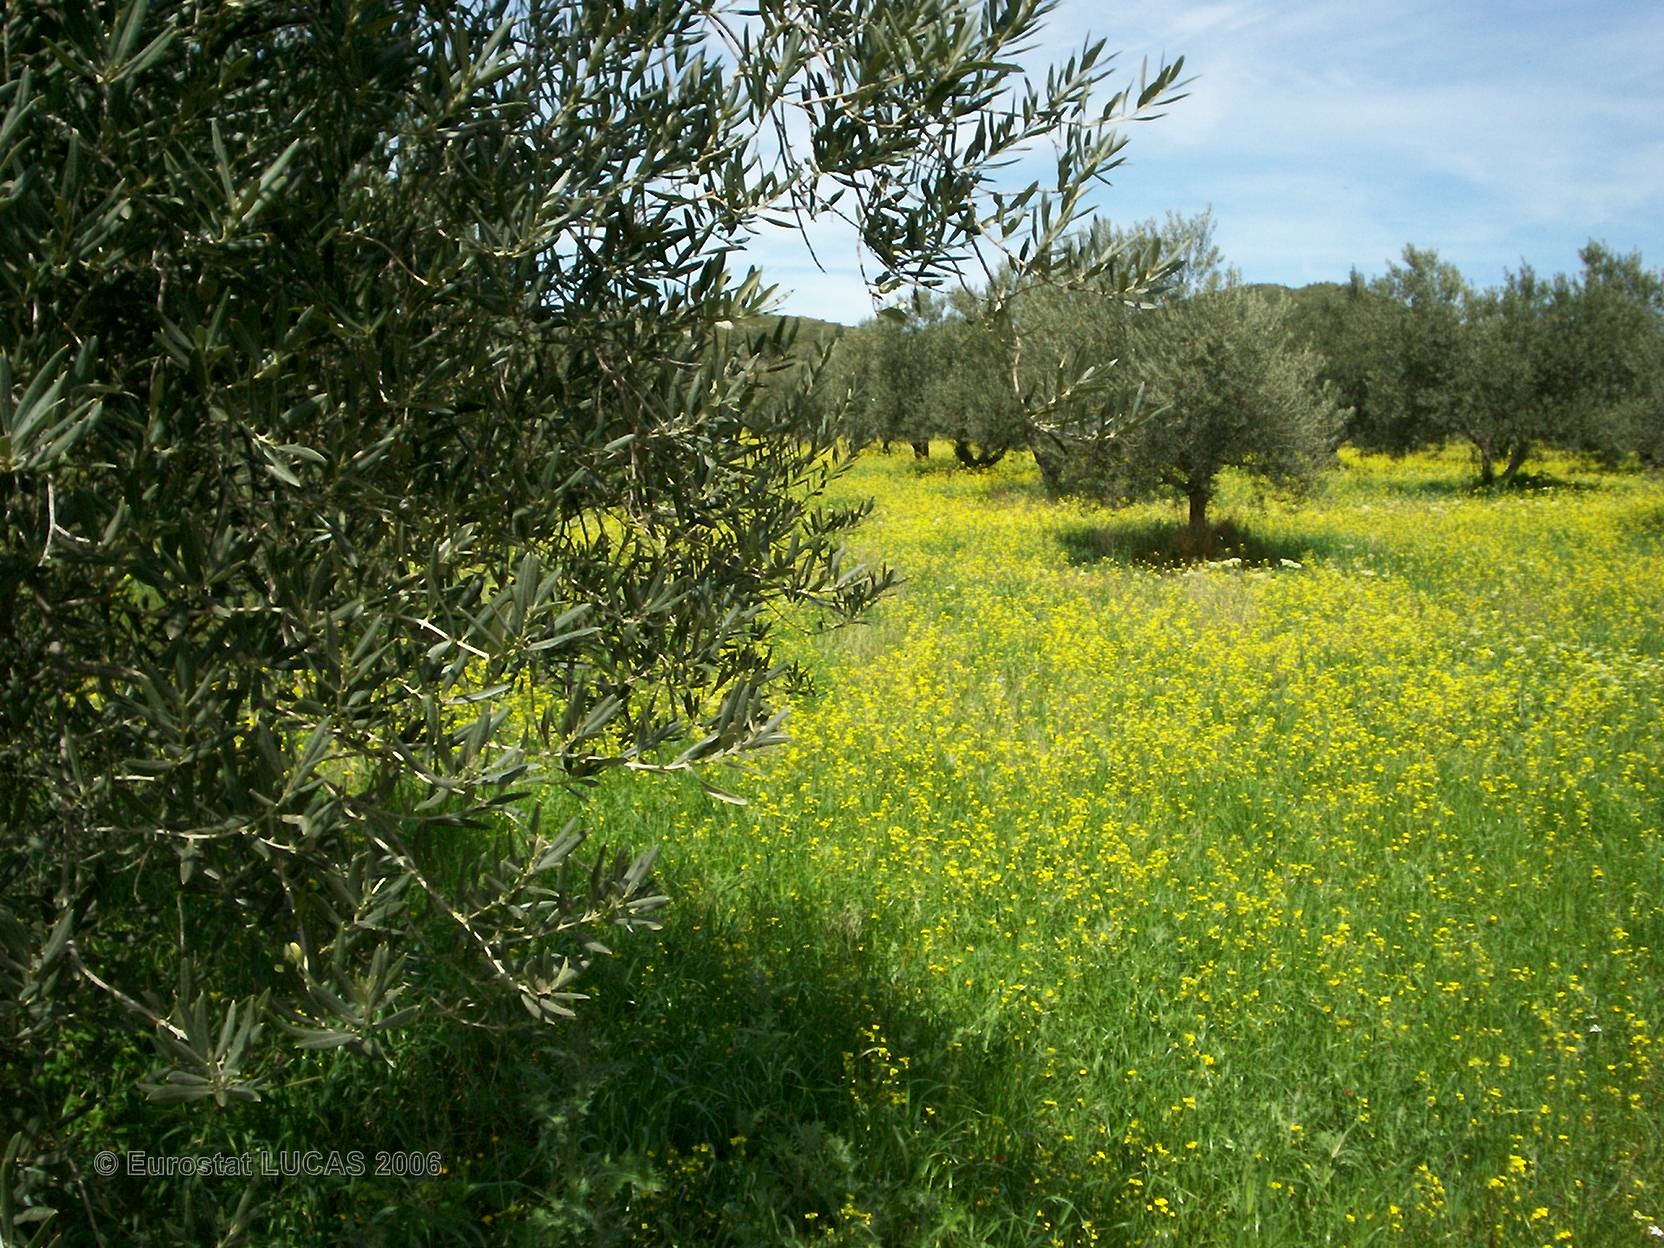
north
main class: Cropland
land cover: Olive groves
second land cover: Grassland with sparse tree/shrub cover
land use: Agriculture (excluding fallow land and kitchen gardens)
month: April
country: FR
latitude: 43.7027
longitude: 4.9340
